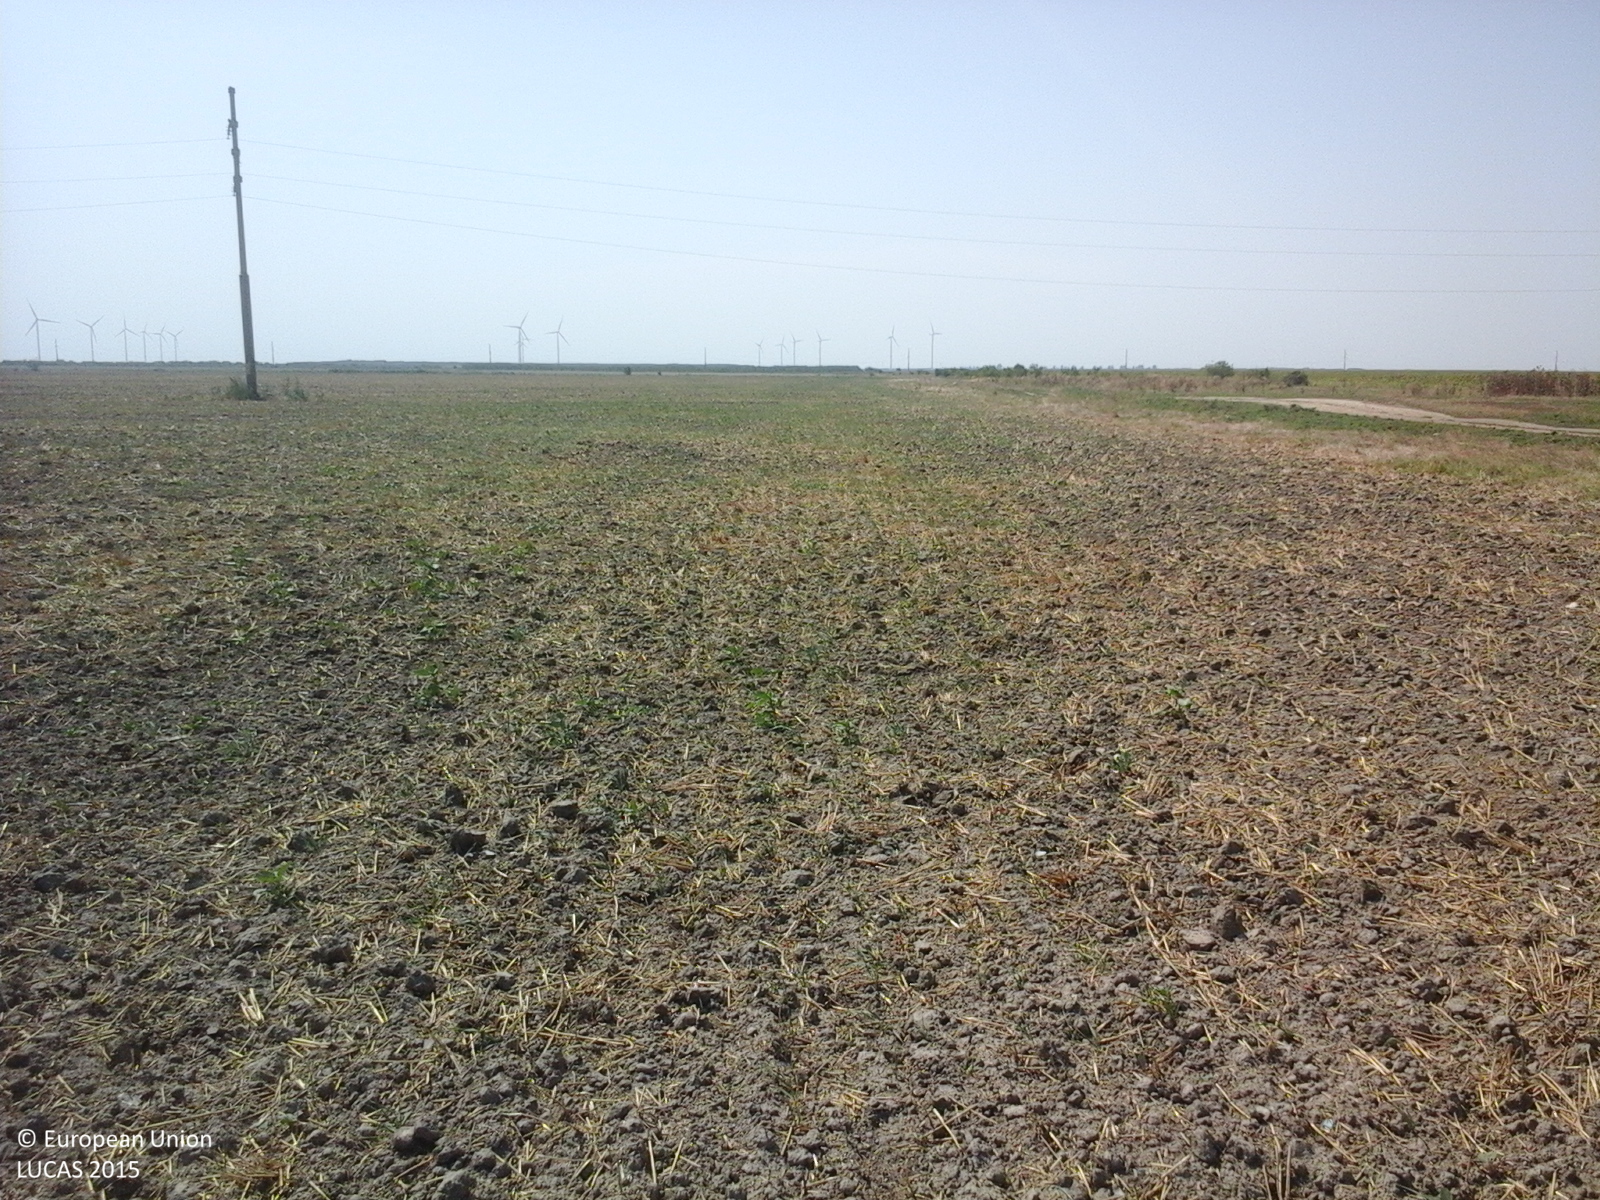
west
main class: Cropland
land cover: Common wheat
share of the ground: < 10 %
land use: Agriculture (excluding fallow land and kitchen gardens)
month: August
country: RO
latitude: 45.2772
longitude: 27.7372
